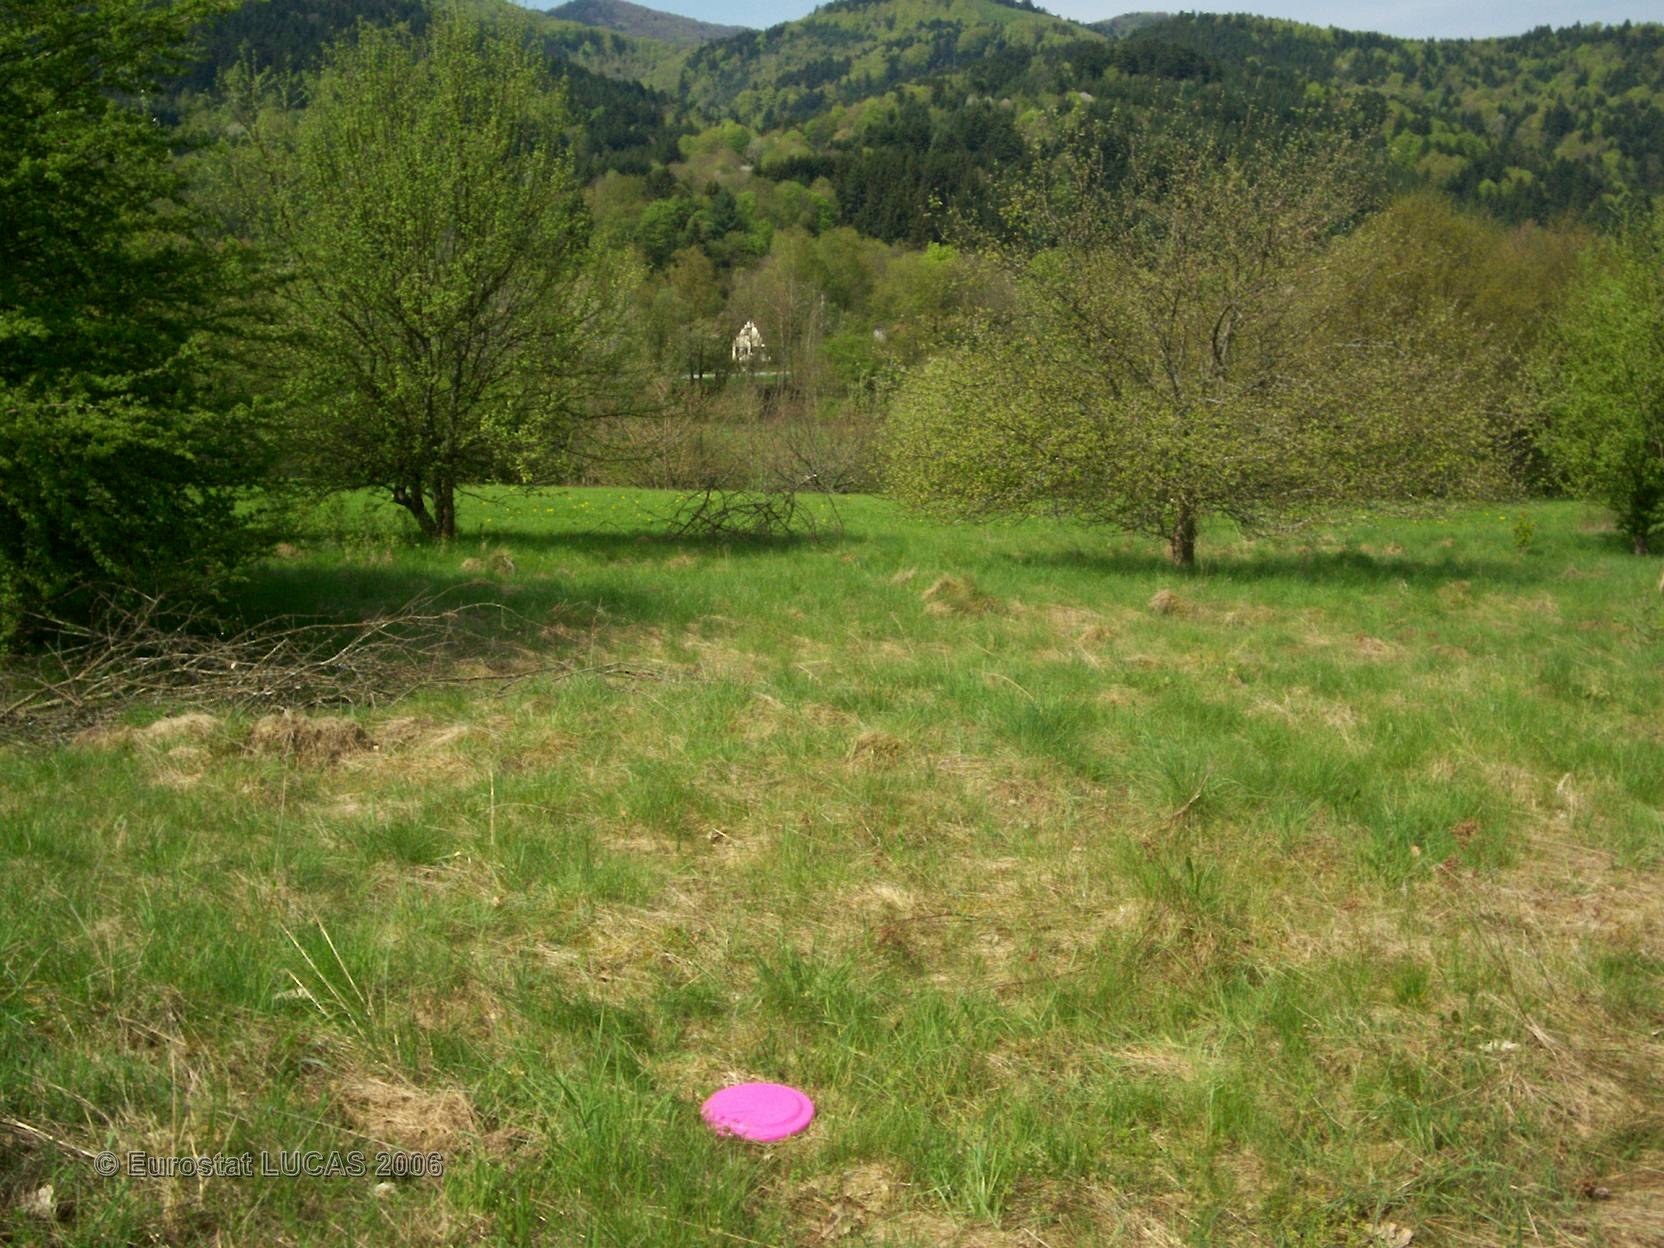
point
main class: Grassland
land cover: Grassland with sparse tree/shrub cover
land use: Agriculture (excluding fallow land and kitchen gardens)
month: May
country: FR
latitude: 47.7858
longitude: 6.9715
